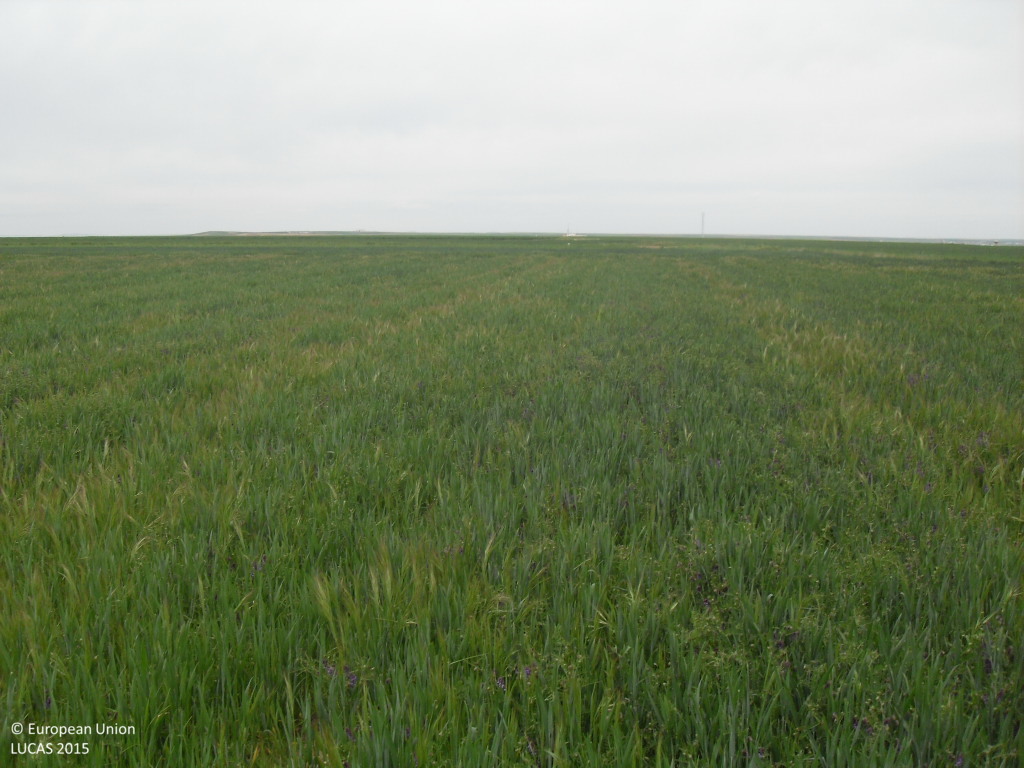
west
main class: Cropland
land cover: Mixed cereals for fodder
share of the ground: > 75 %
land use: Agriculture (excluding fallow land and kitchen gardens)
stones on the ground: 10 - 25 %
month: April
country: ES
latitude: 40.8403
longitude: -5.1879
